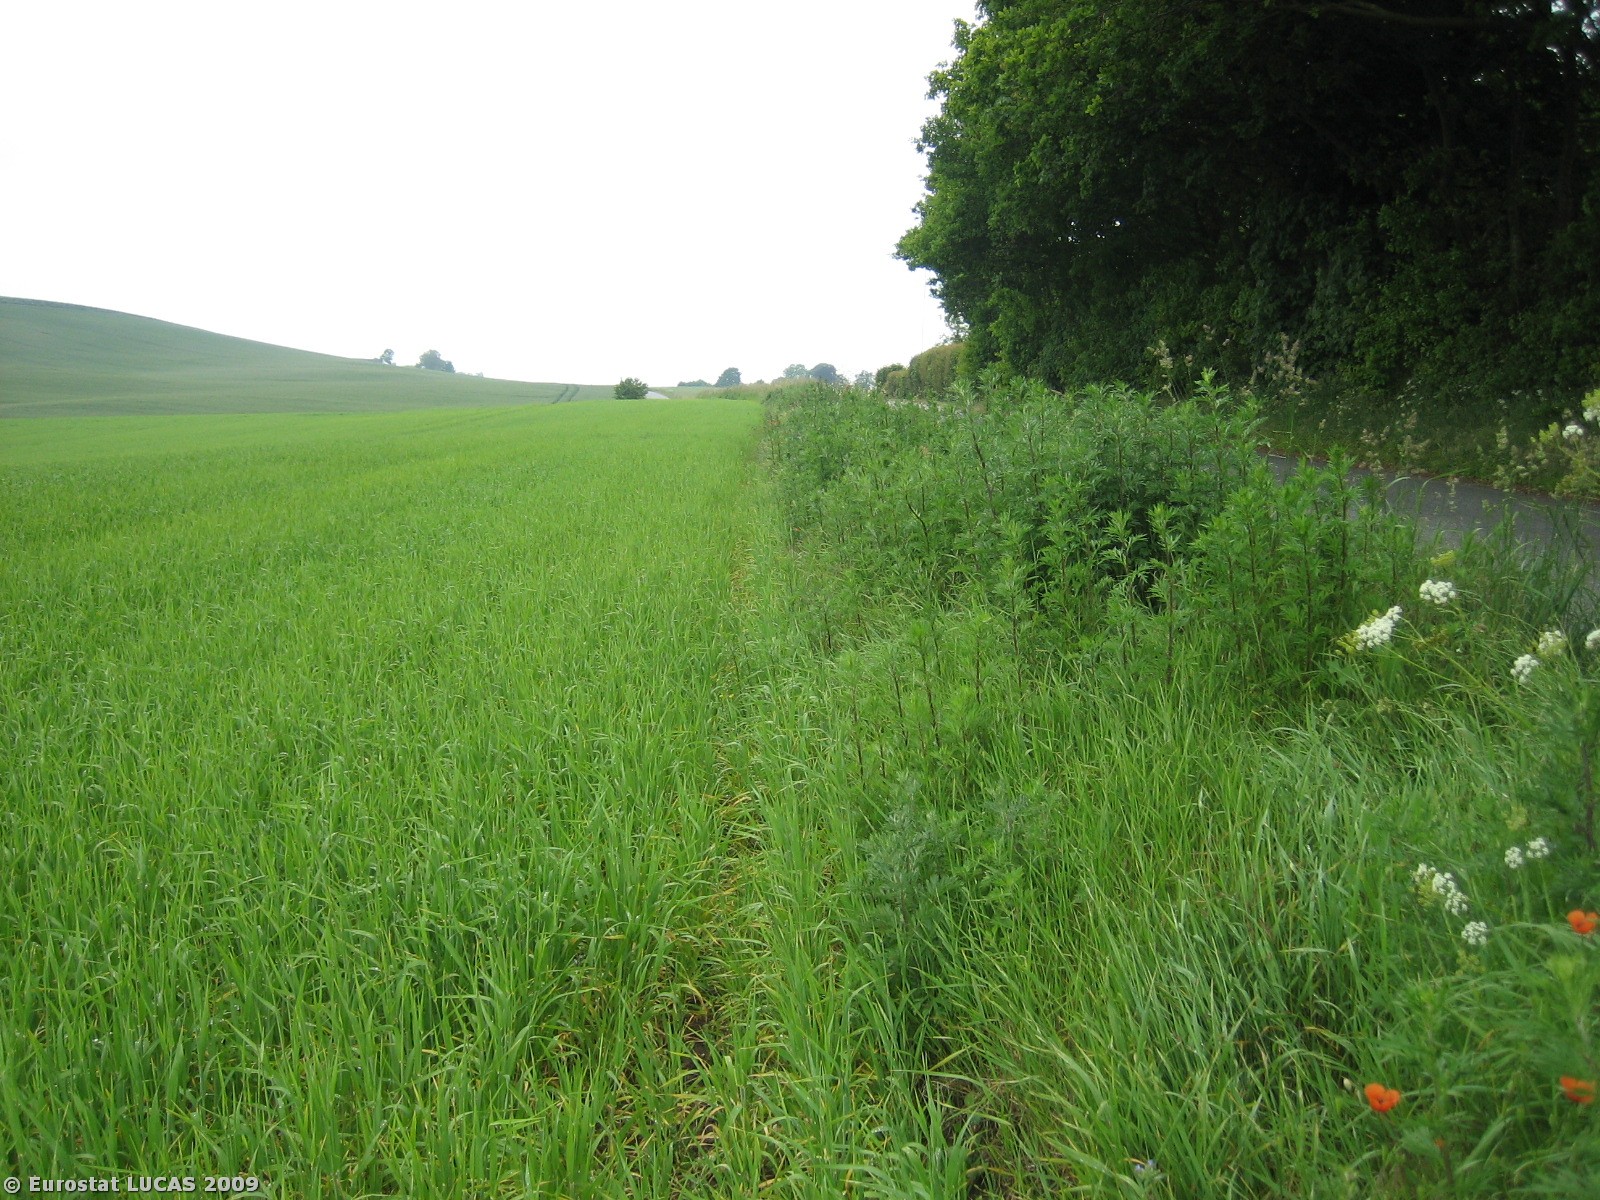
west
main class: Cropland
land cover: Barley
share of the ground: > 75 %
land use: Agriculture (excluding fallow land and kitchen gardens)
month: June
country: DK
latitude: 56.2056
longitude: 10.1449
